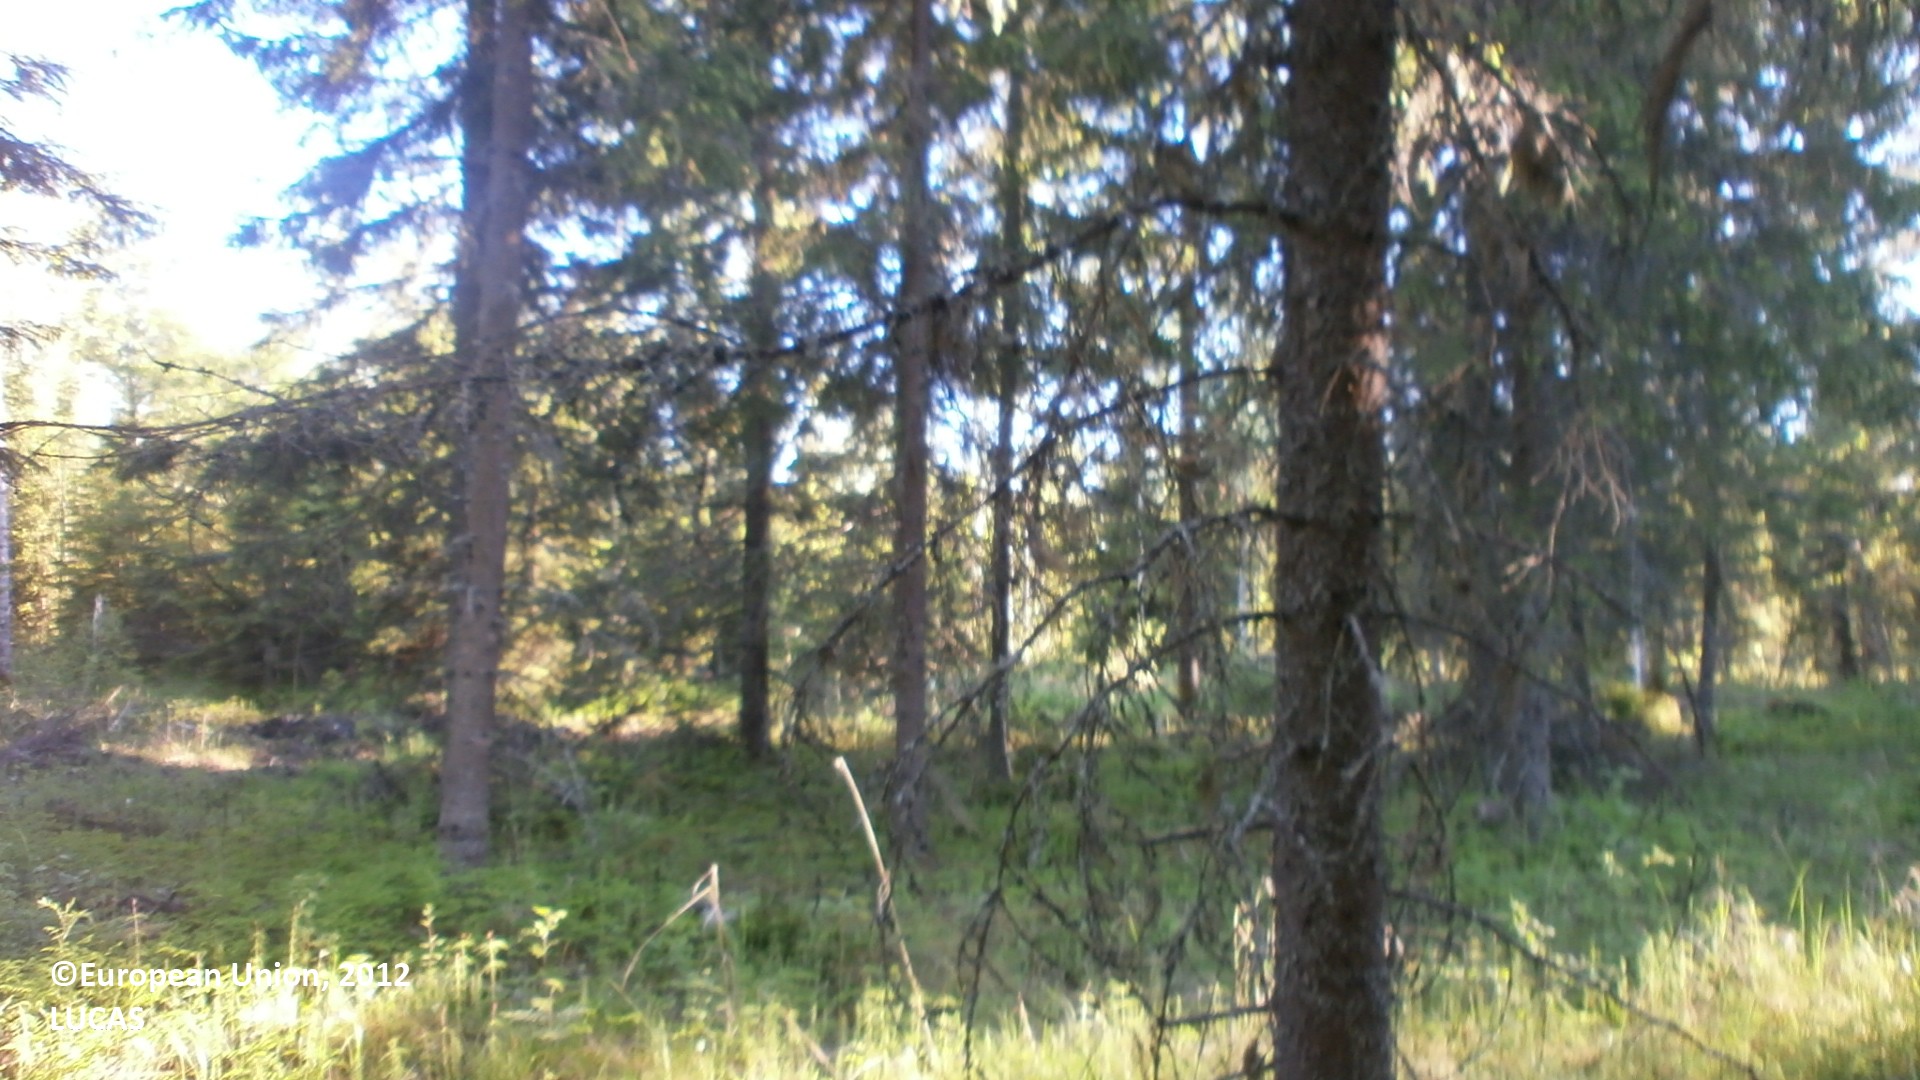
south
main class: Woodland
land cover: Spruce dominated coniferous woodland
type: mire and swamp forests
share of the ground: 50 - 75 %
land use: Forestry
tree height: > 5 m
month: June
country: FI
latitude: 64.0853
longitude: 25.7485
